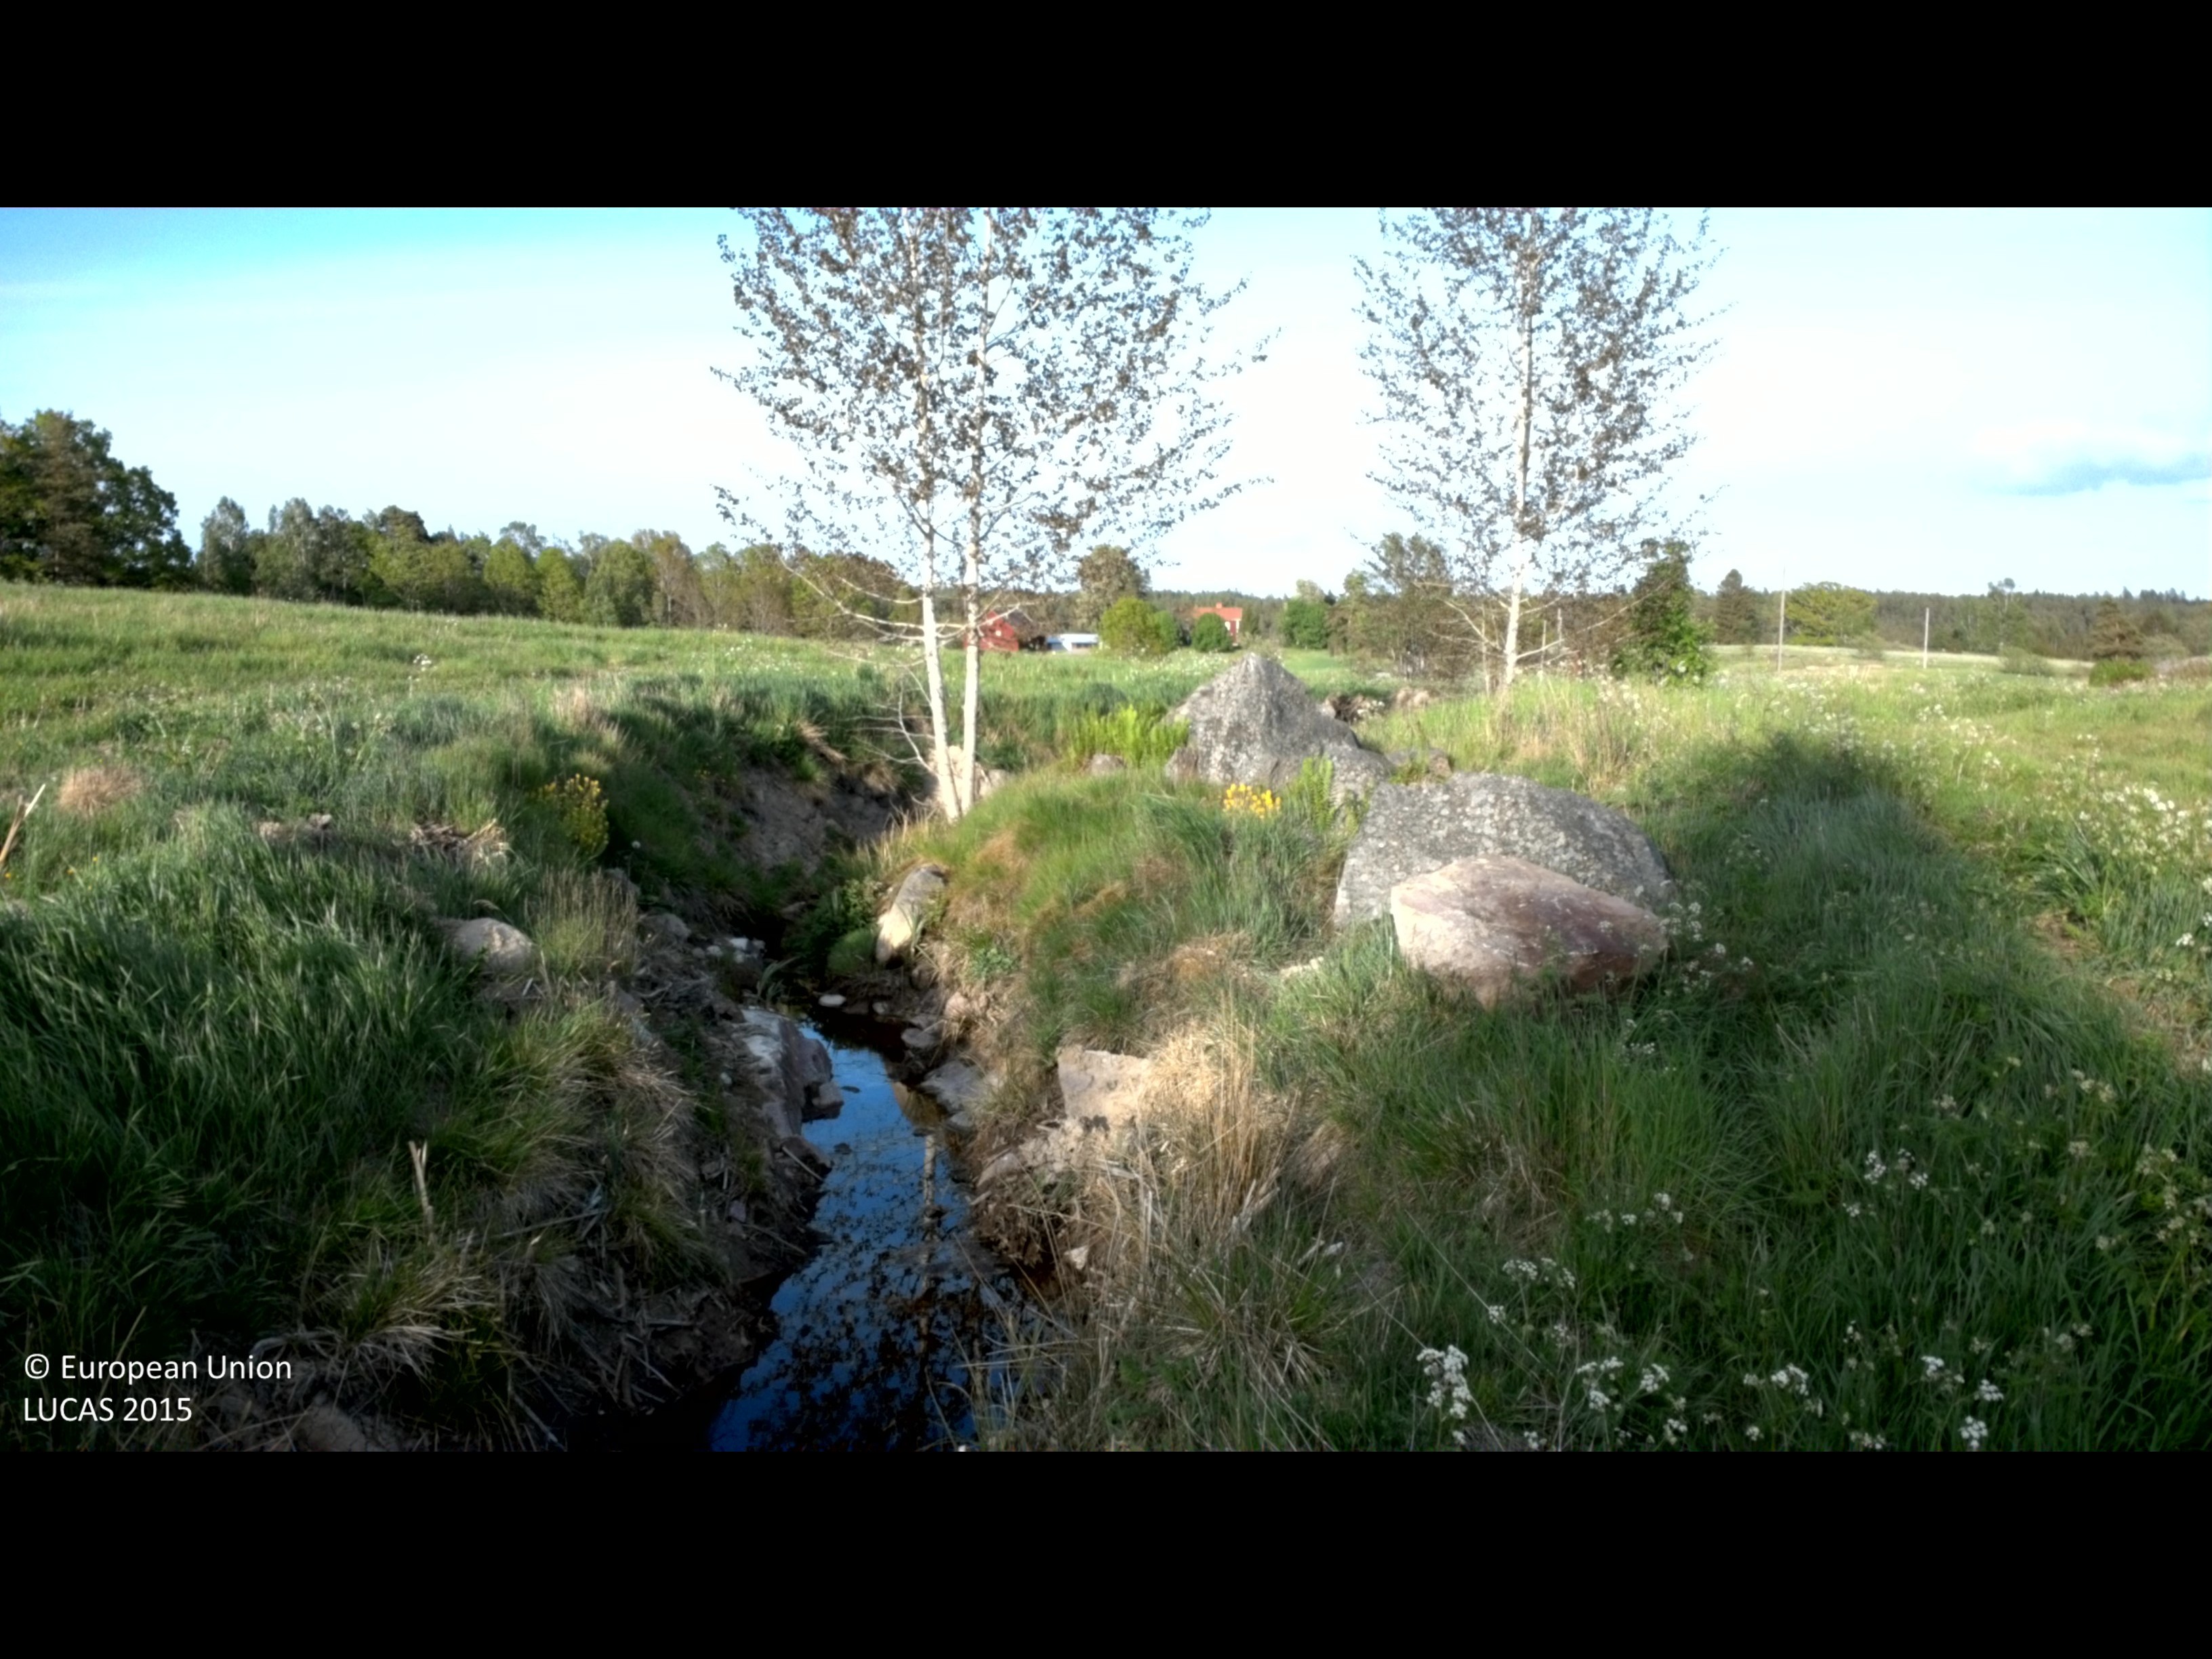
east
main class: Grassland
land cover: Grassland without tree/shrub cover
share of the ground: > 75 %
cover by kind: herbaceous plants 100 %
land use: Agriculture (excluding fallow land and kitchen gardens)
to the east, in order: Grassland without tree/shrub cover; Grassland with sparse tree/shrub cover; Ditches and canals; Grassland without tree/shrub cover; Ditches and canals; Grassland with sparse tree/shrub cover; Ditches and canals; Grass margins; Paved roads, cycling and walking lanes; Grass margins; Ditches and canals; Other leguminous and mixtures for fodder; Ditches and canals; Grass margins; Paved roads, cycling and walking lanes; Grass margins; Ditches and canals; Grass margins; Temporary grasslands
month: June
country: SE
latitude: 57.6443
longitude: 16.1799
